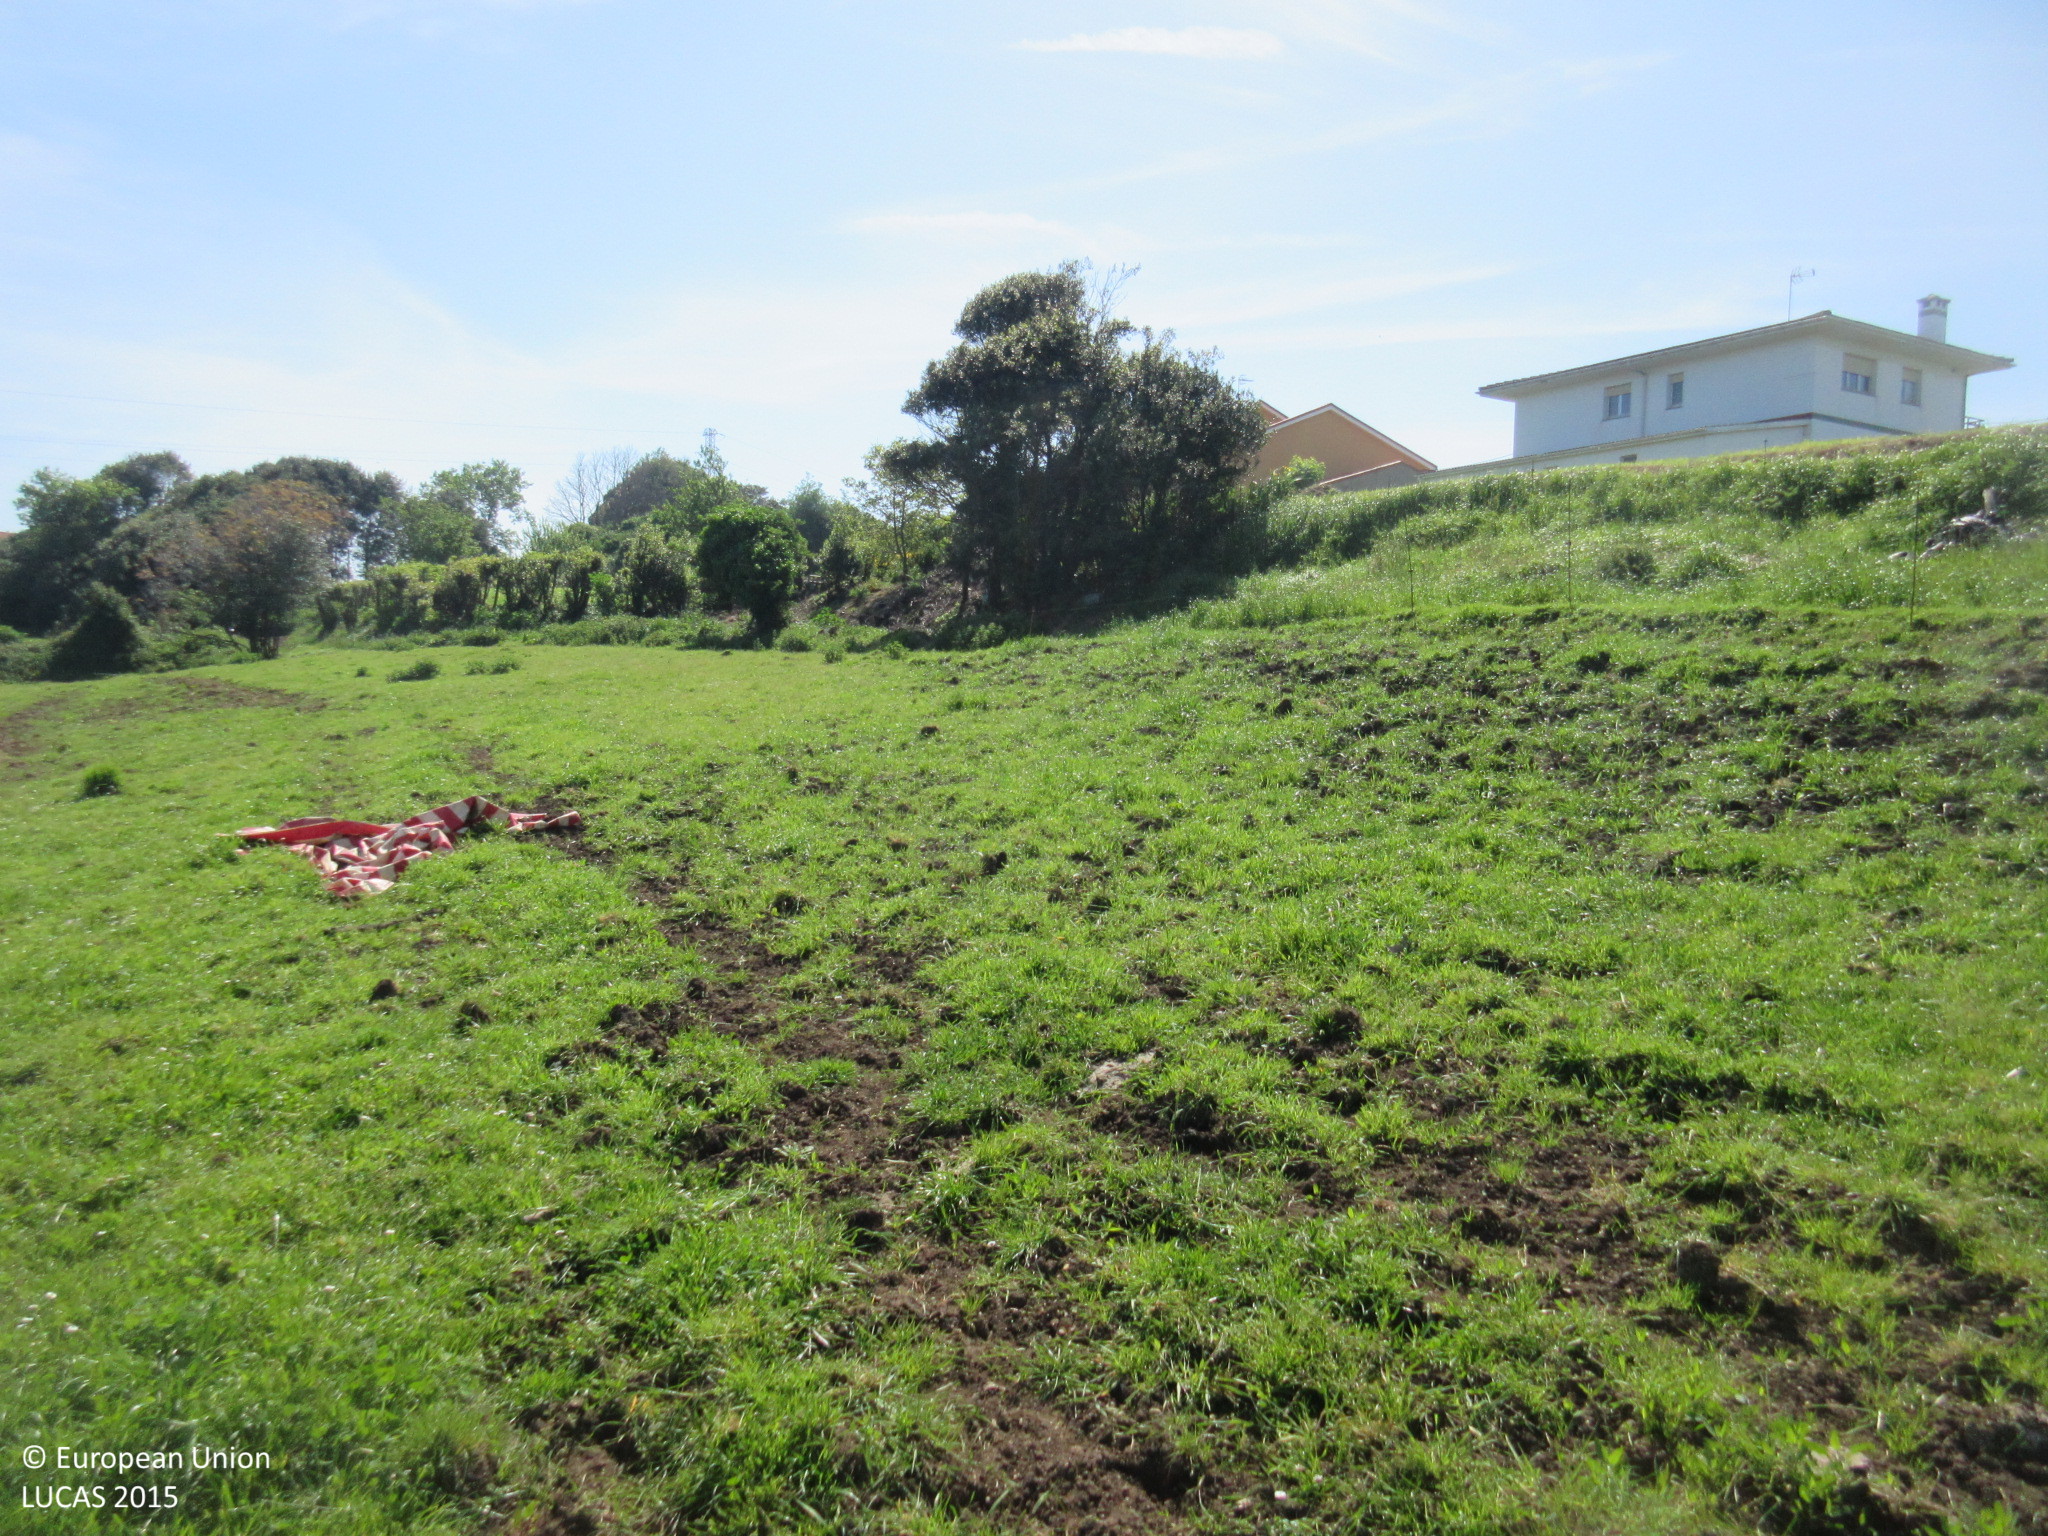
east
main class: Grassland
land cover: Grassland without tree/shrub cover
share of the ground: > 75 %
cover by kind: herbaceous plants 100 %
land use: Agriculture (excluding fallow land and kitchen gardens)
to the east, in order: Grassland without tree/shrub cover; Single bushes/trees; Tracks; Groves; Grassland with sparse tree/shrub cover; Paved roads, cycling and walking lanes; Shrubland with sparse tree cover; Grassland without tree/shrub cover; Dry stone walls; Grassland with sparse tree/shrub cover; Grassland without tree/shrub cover; Electric lines; Grassland without tree/shrub cover; Fences; Grassland with sparse tree/shrub cover; Artificial constructions
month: May
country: ES
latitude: 43.5911
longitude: -5.9087
